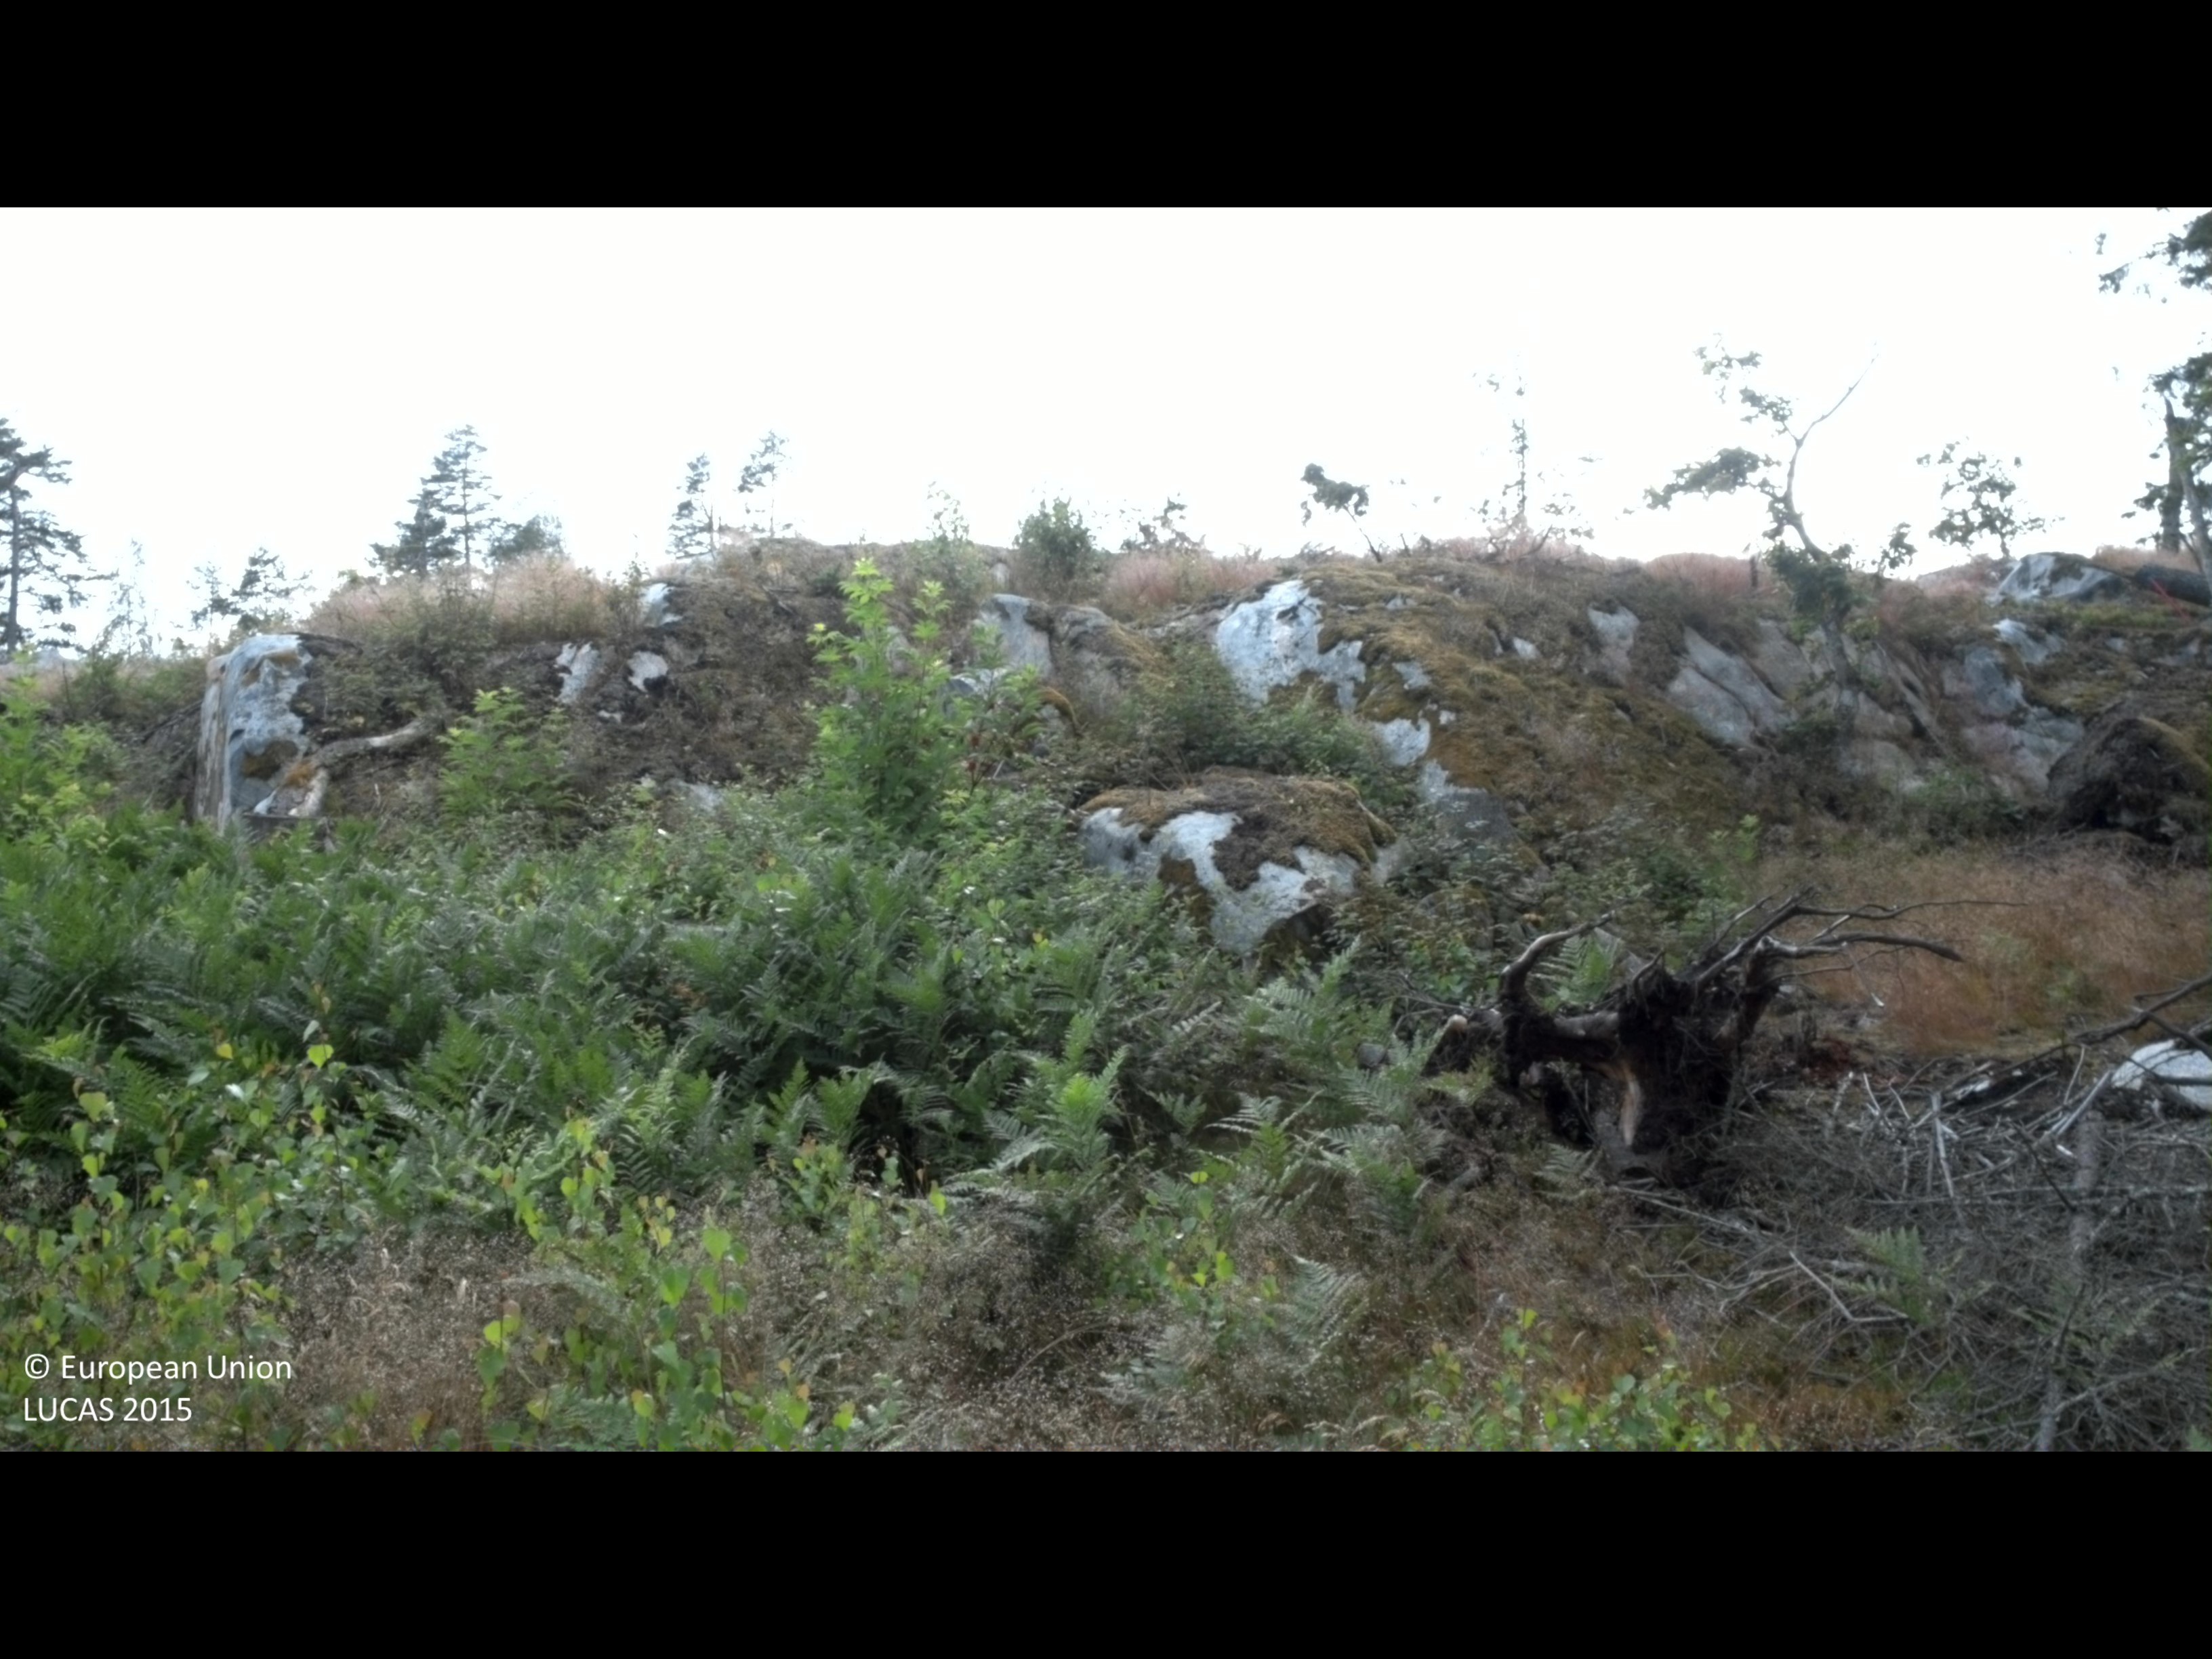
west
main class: Woodland
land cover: Broadleaved woodland
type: boreal forest
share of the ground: 10 - 25 %
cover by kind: herbaceous plants 60 %, broadleaved forest trees 20 %, shrubs 10 %, lichens and mosses 10 %
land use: Forestry
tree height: < 5 m
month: July
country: SE
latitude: 58.1051
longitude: 16.3604
